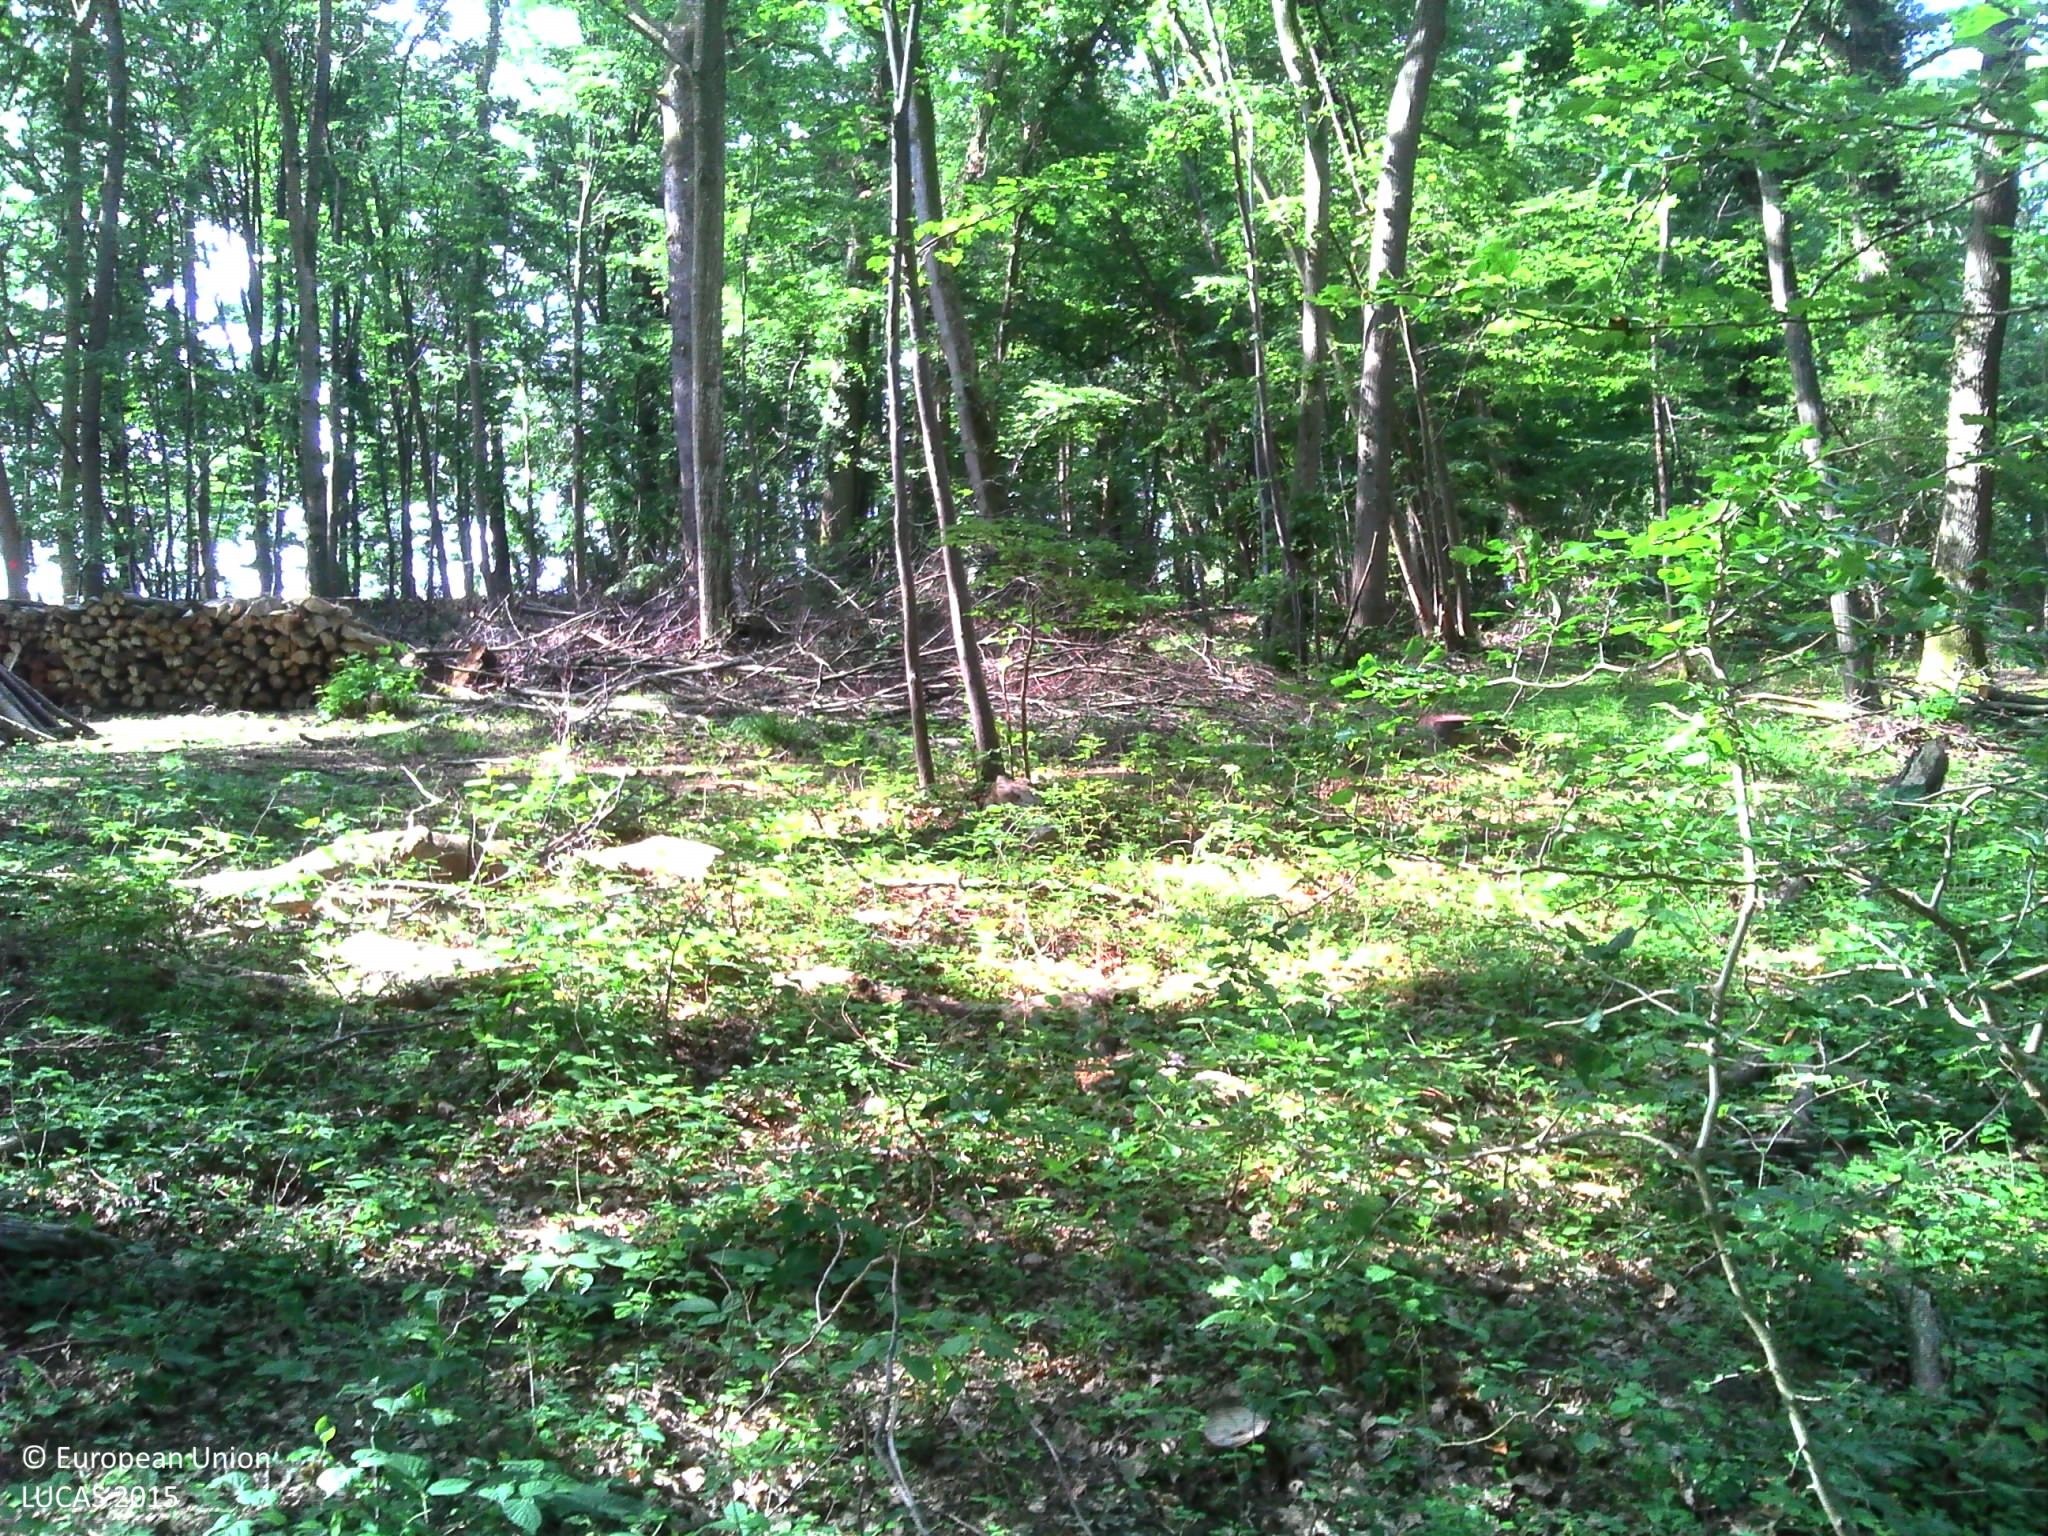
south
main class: Woodland
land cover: Broadleaved woodland
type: acidophilous oak and oak-birch forest
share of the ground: > 75 %
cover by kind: broadleaved forest trees 90 %, herbaceous plants 5 %, lichens and mosses 5 %
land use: Forestry
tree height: > 5 m
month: June
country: FR
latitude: 48.6897
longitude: 6.4819
